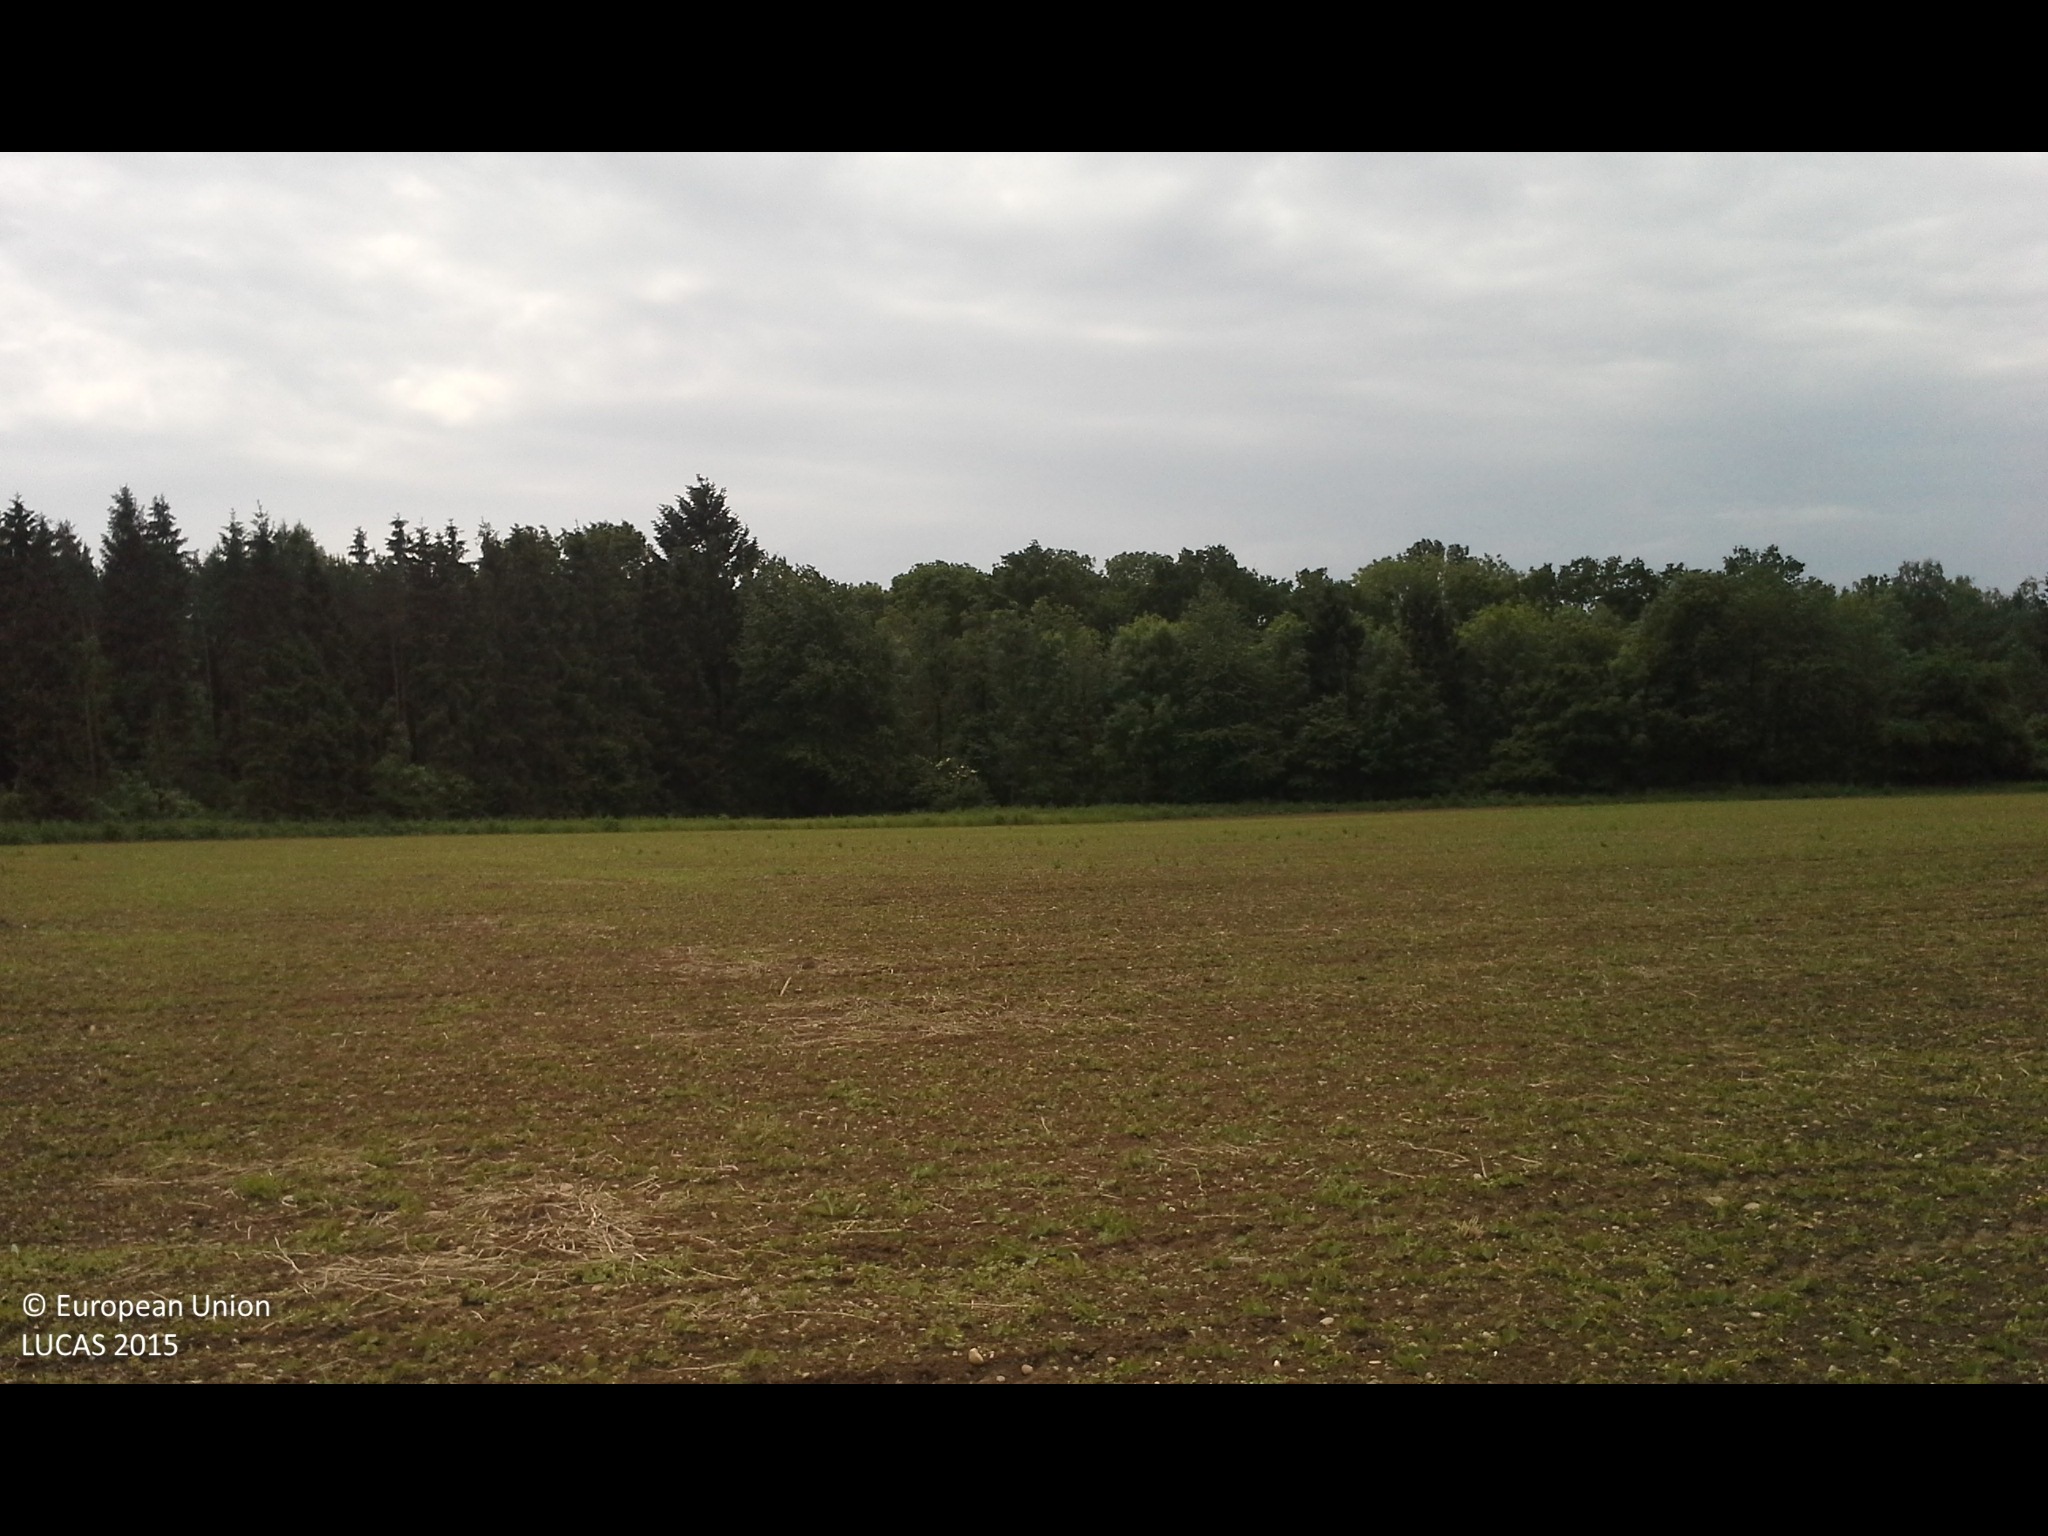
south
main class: Cropland
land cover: Soya
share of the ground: 10 - 25 %
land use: Agriculture (excluding fallow land and kitchen gardens)
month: May
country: AT
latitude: 48.1676
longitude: 14.5047
